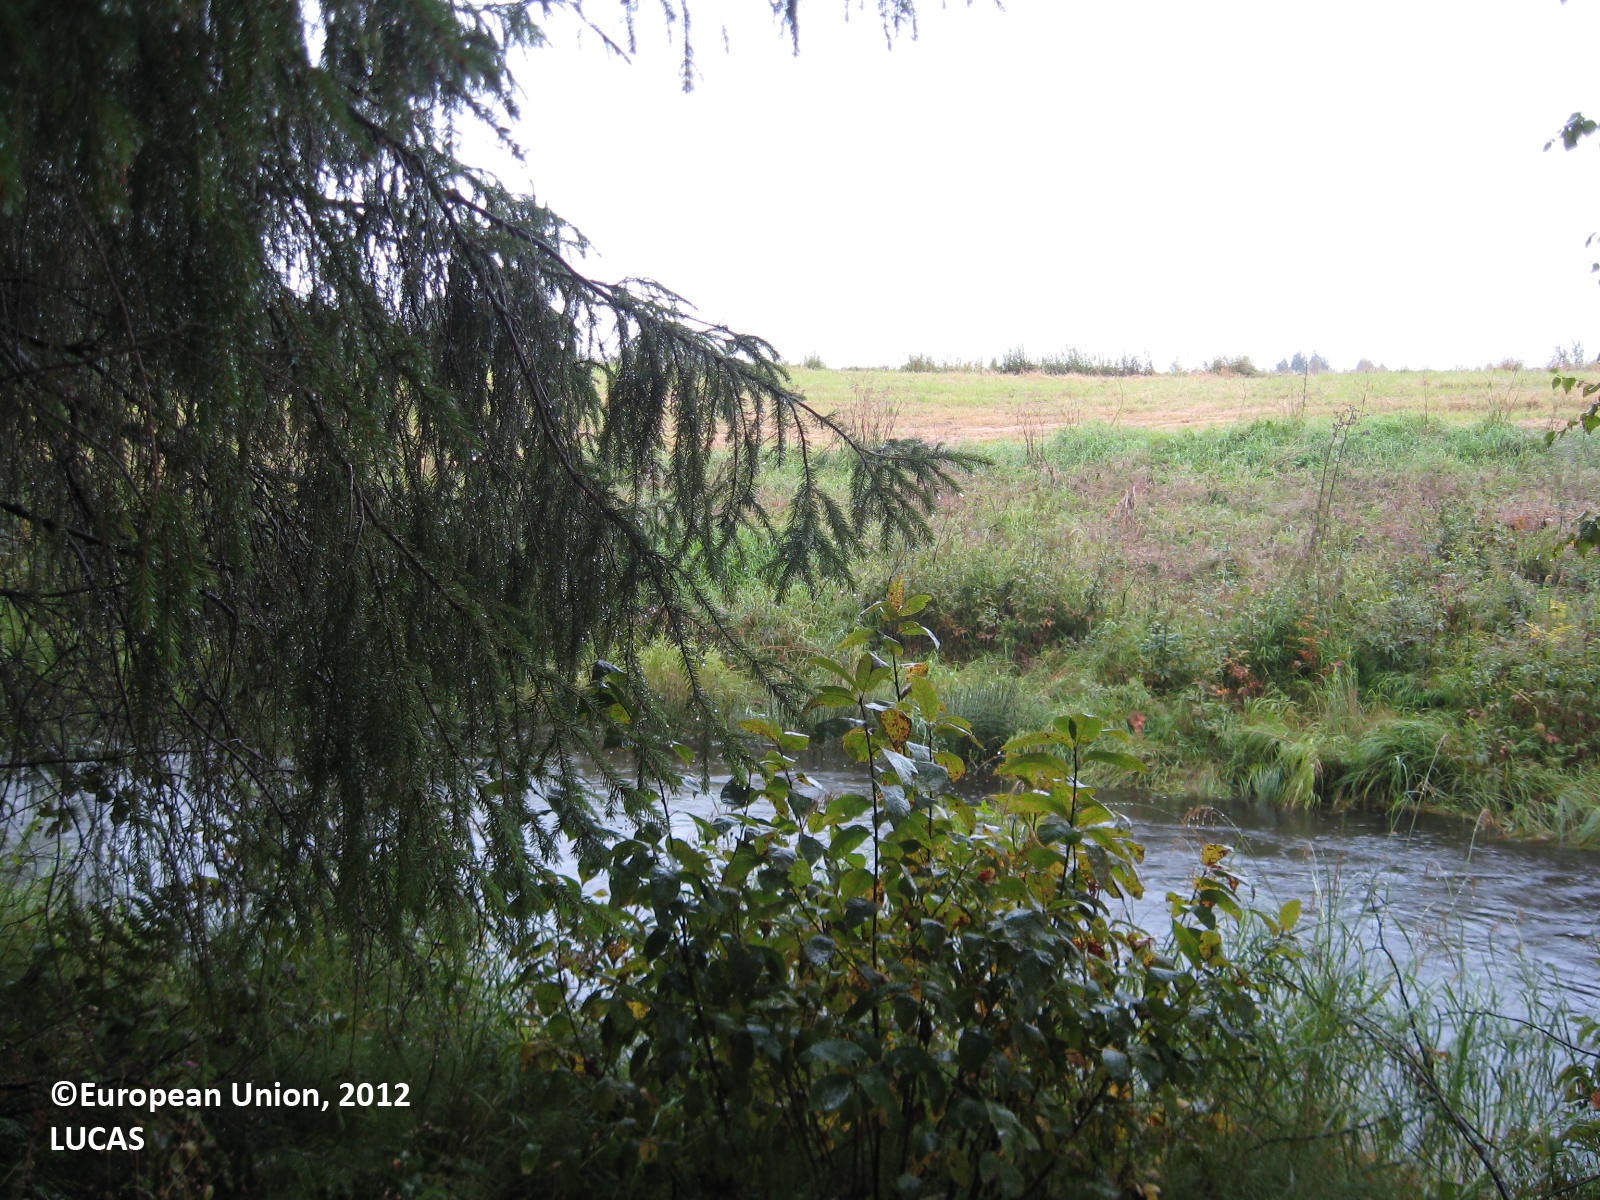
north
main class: Woodland
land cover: Other mixed woodland
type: boreal forest
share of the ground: > 75 %
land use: Forestry
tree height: > 5 m
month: August
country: FI
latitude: 63.5028
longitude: 29.6605
